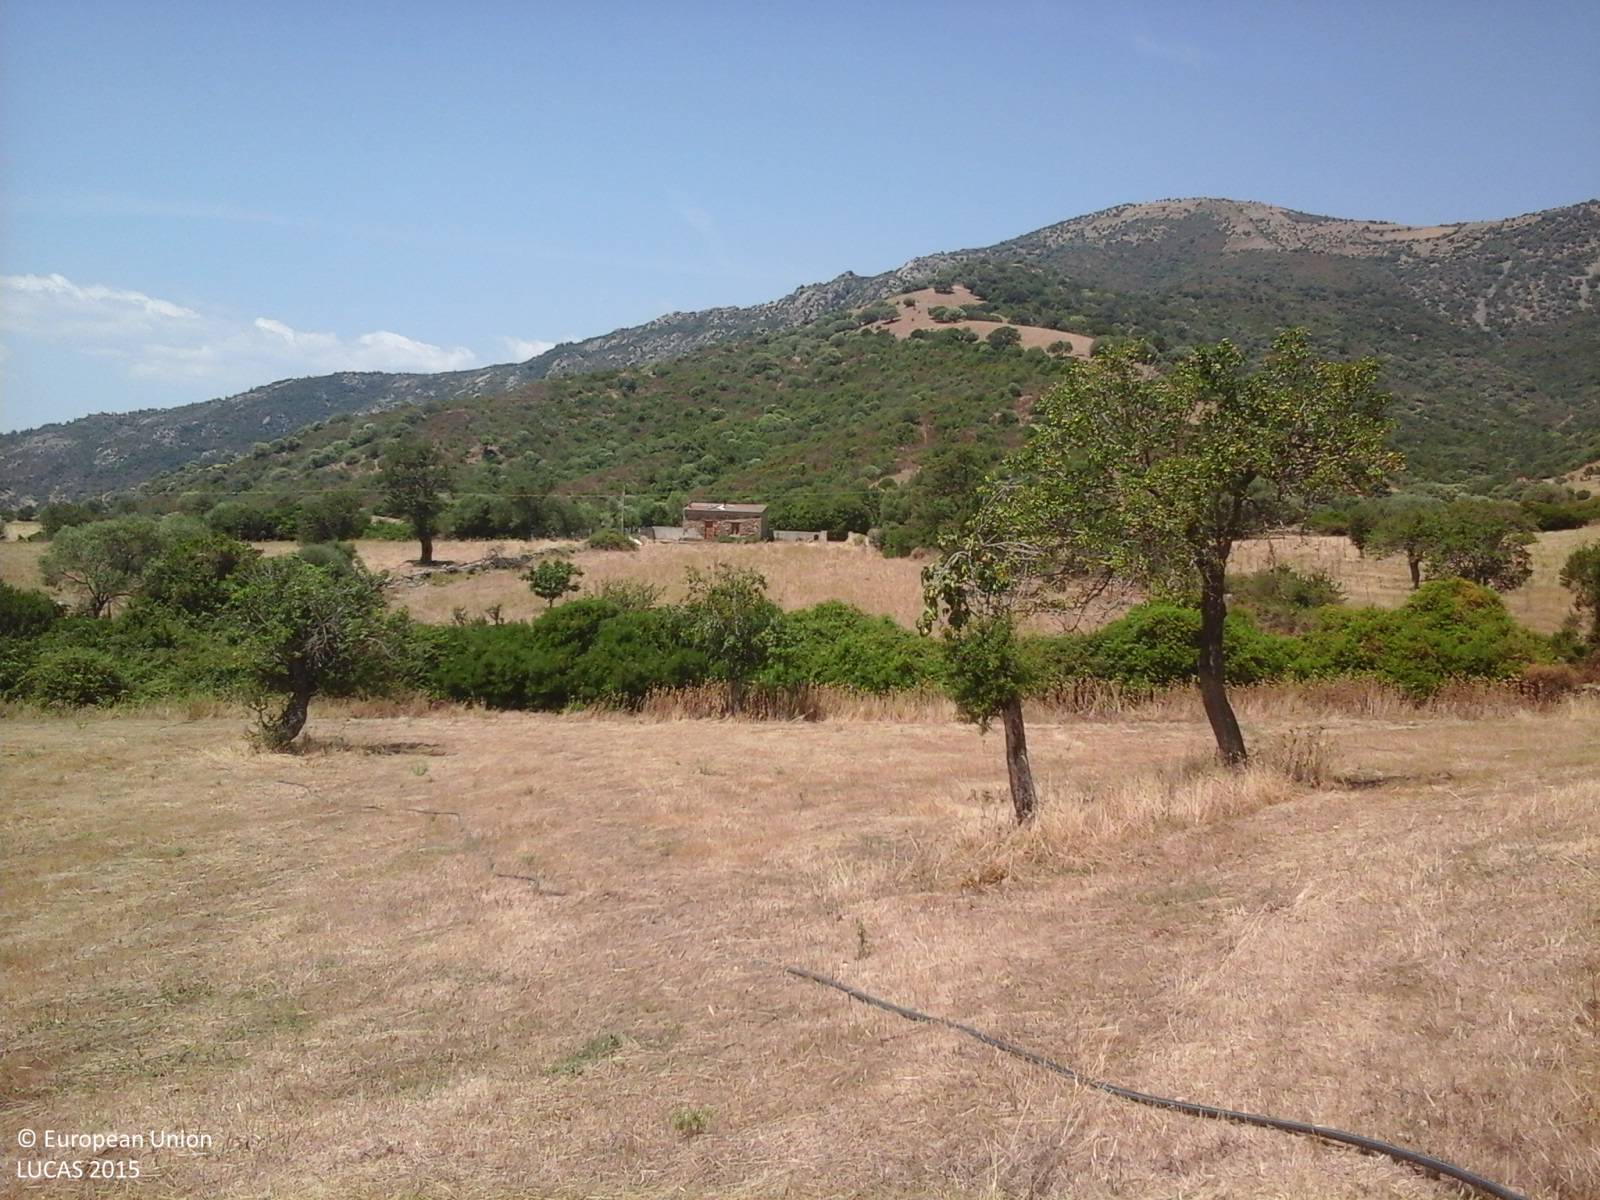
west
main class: Grassland
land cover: Grassland without tree/shrub cover
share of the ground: > 75 %
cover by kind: herbaceous plants 95 %, unconsolidated bare surface 5 %
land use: Agriculture (excluding fallow land and kitchen gardens)
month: June
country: IT
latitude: 40.6648
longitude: 9.6351
